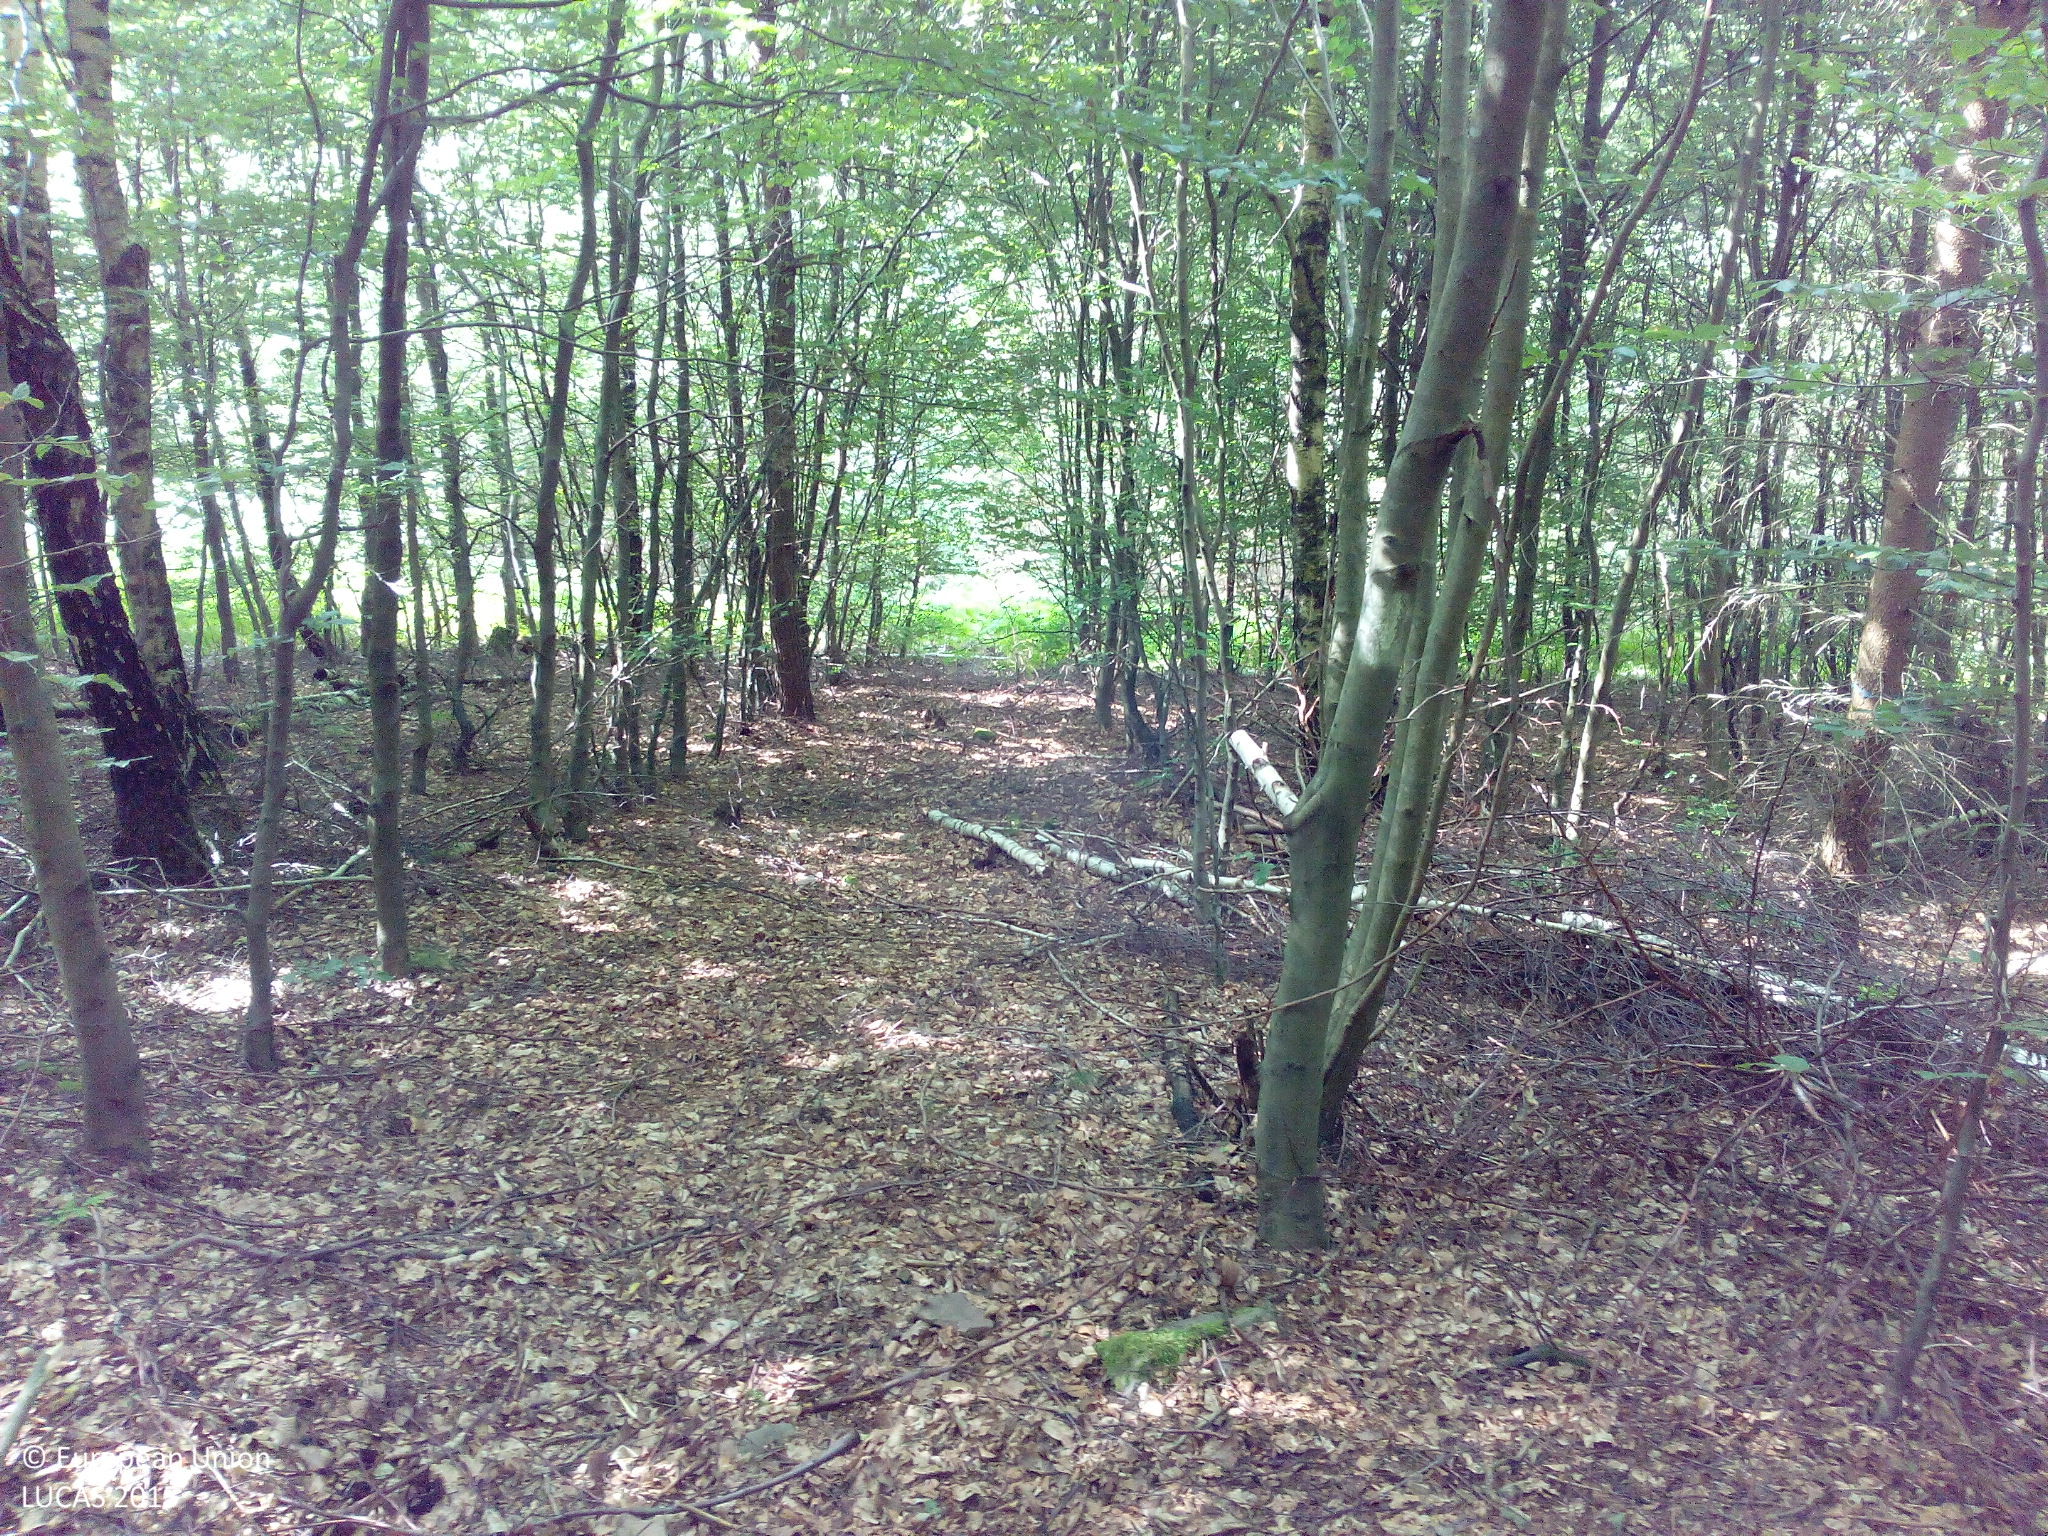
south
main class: Woodland
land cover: Broadleaved woodland
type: beech forest
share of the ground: > 75 %
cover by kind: broadleaved forest trees 100 %
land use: Forestry
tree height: > 5 m
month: July
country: DE
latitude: 50.5798
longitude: 9.9012
